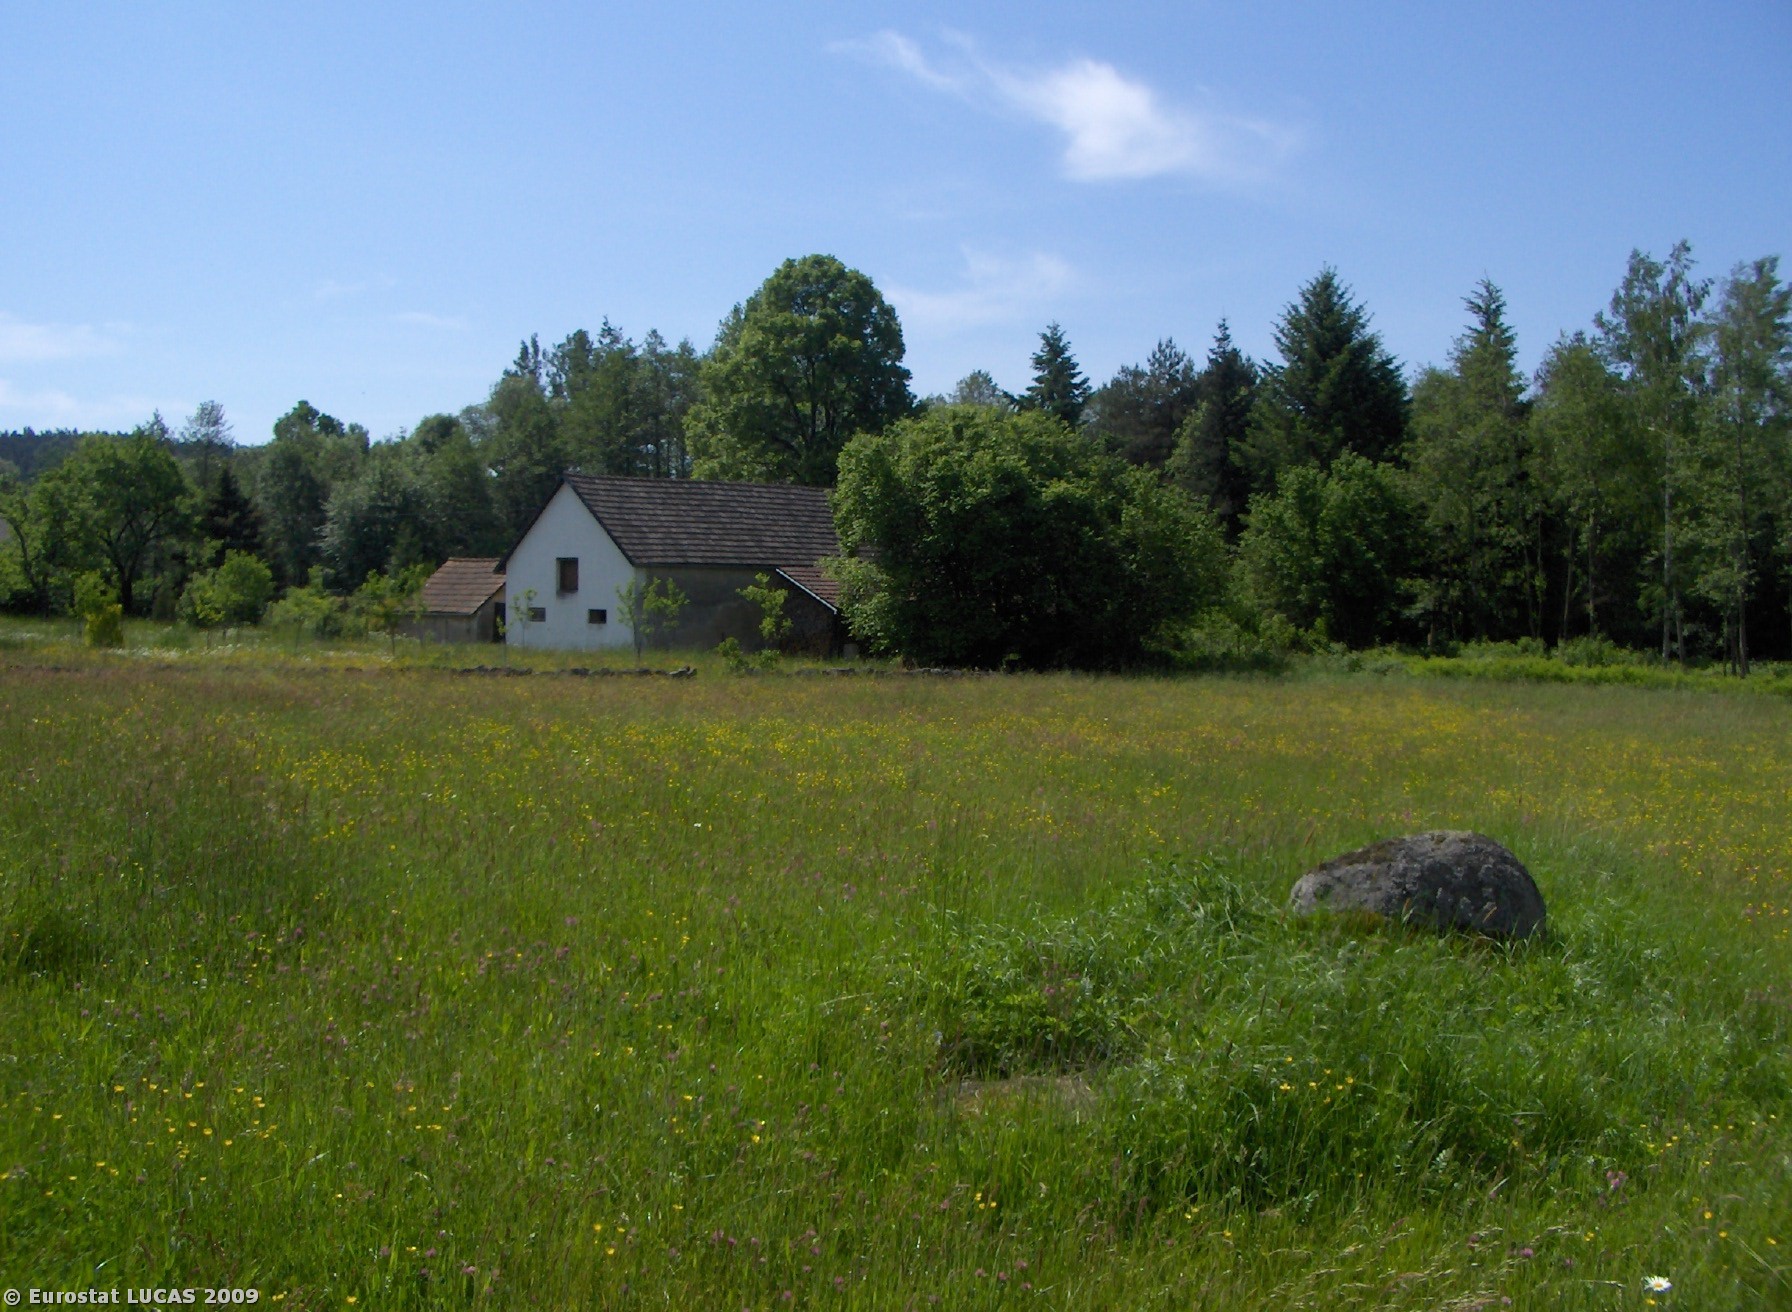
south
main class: Grassland
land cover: Grassland without tree/shrub cover
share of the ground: > 75 %
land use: Agriculture (excluding fallow land and kitchen gardens)
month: May
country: CZ
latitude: 49.5607
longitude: 14.3562
